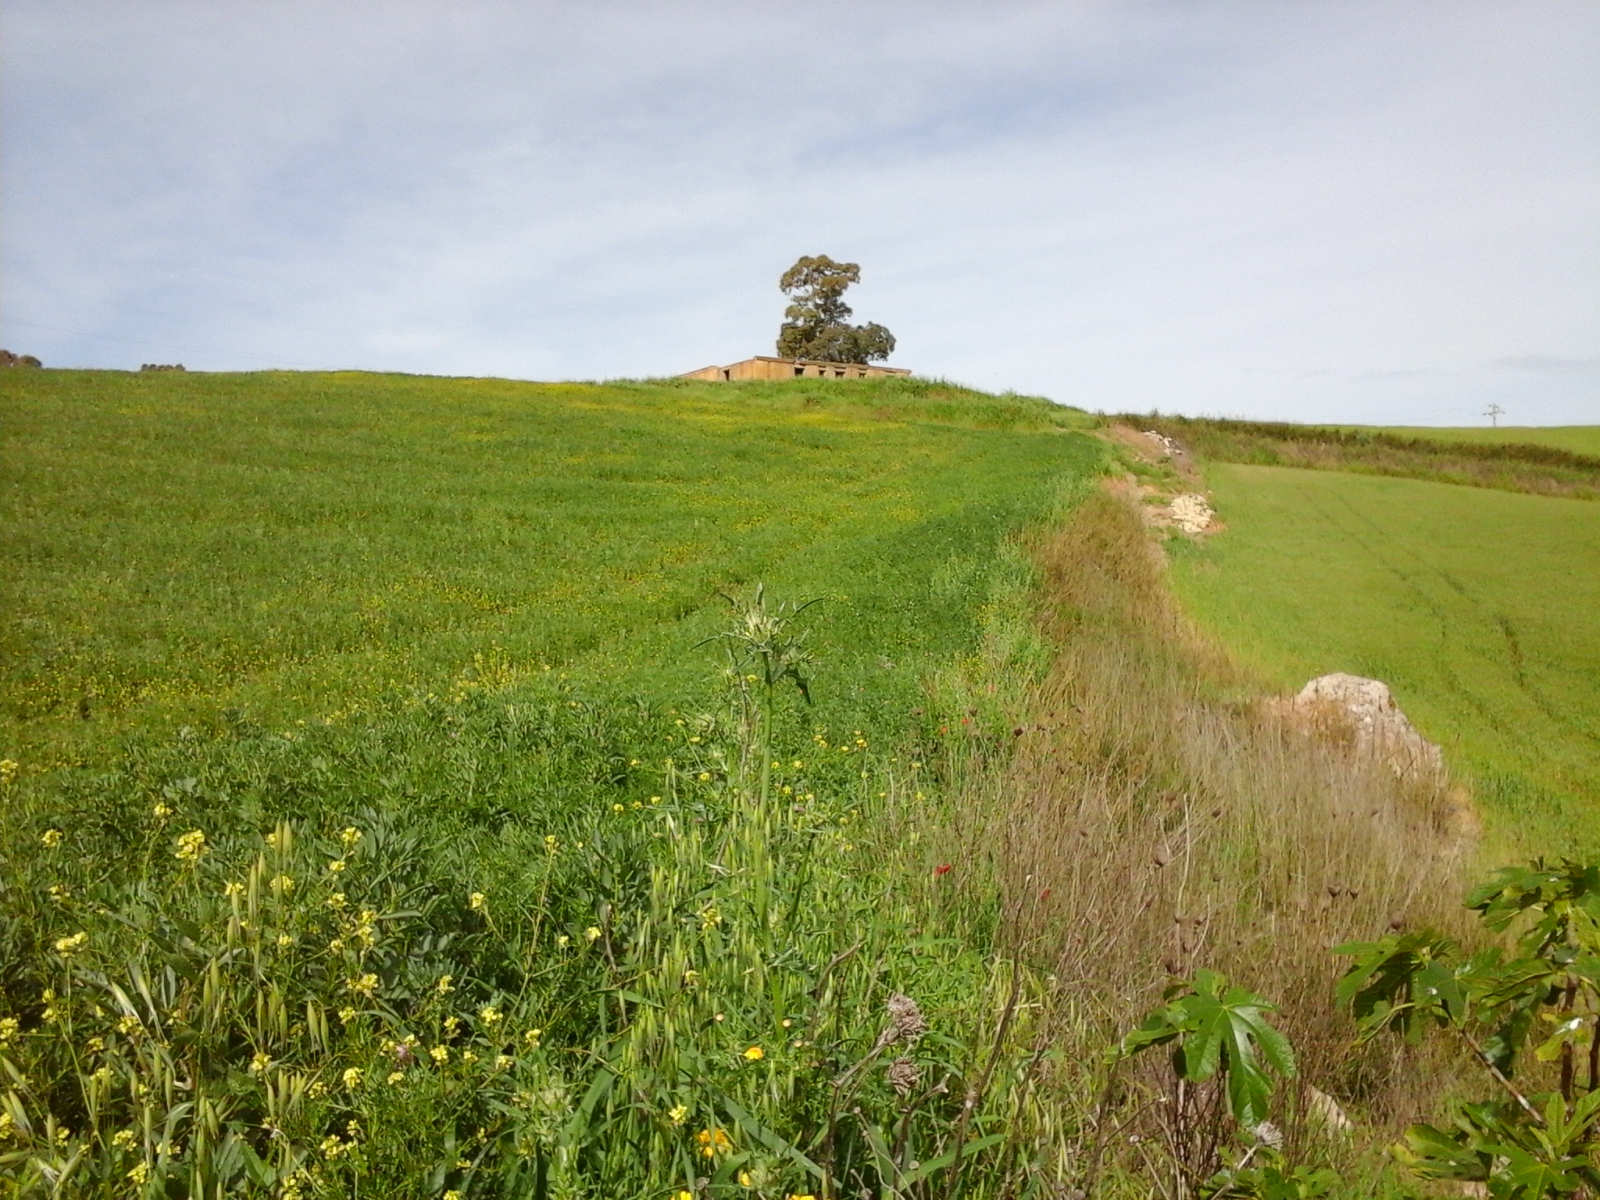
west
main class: Cropland
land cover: Other leguminous and mixtures for fodder
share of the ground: > 75 %
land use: Agriculture (excluding fallow land and kitchen gardens)
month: May
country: IT
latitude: 37.4403
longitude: 14.1170
